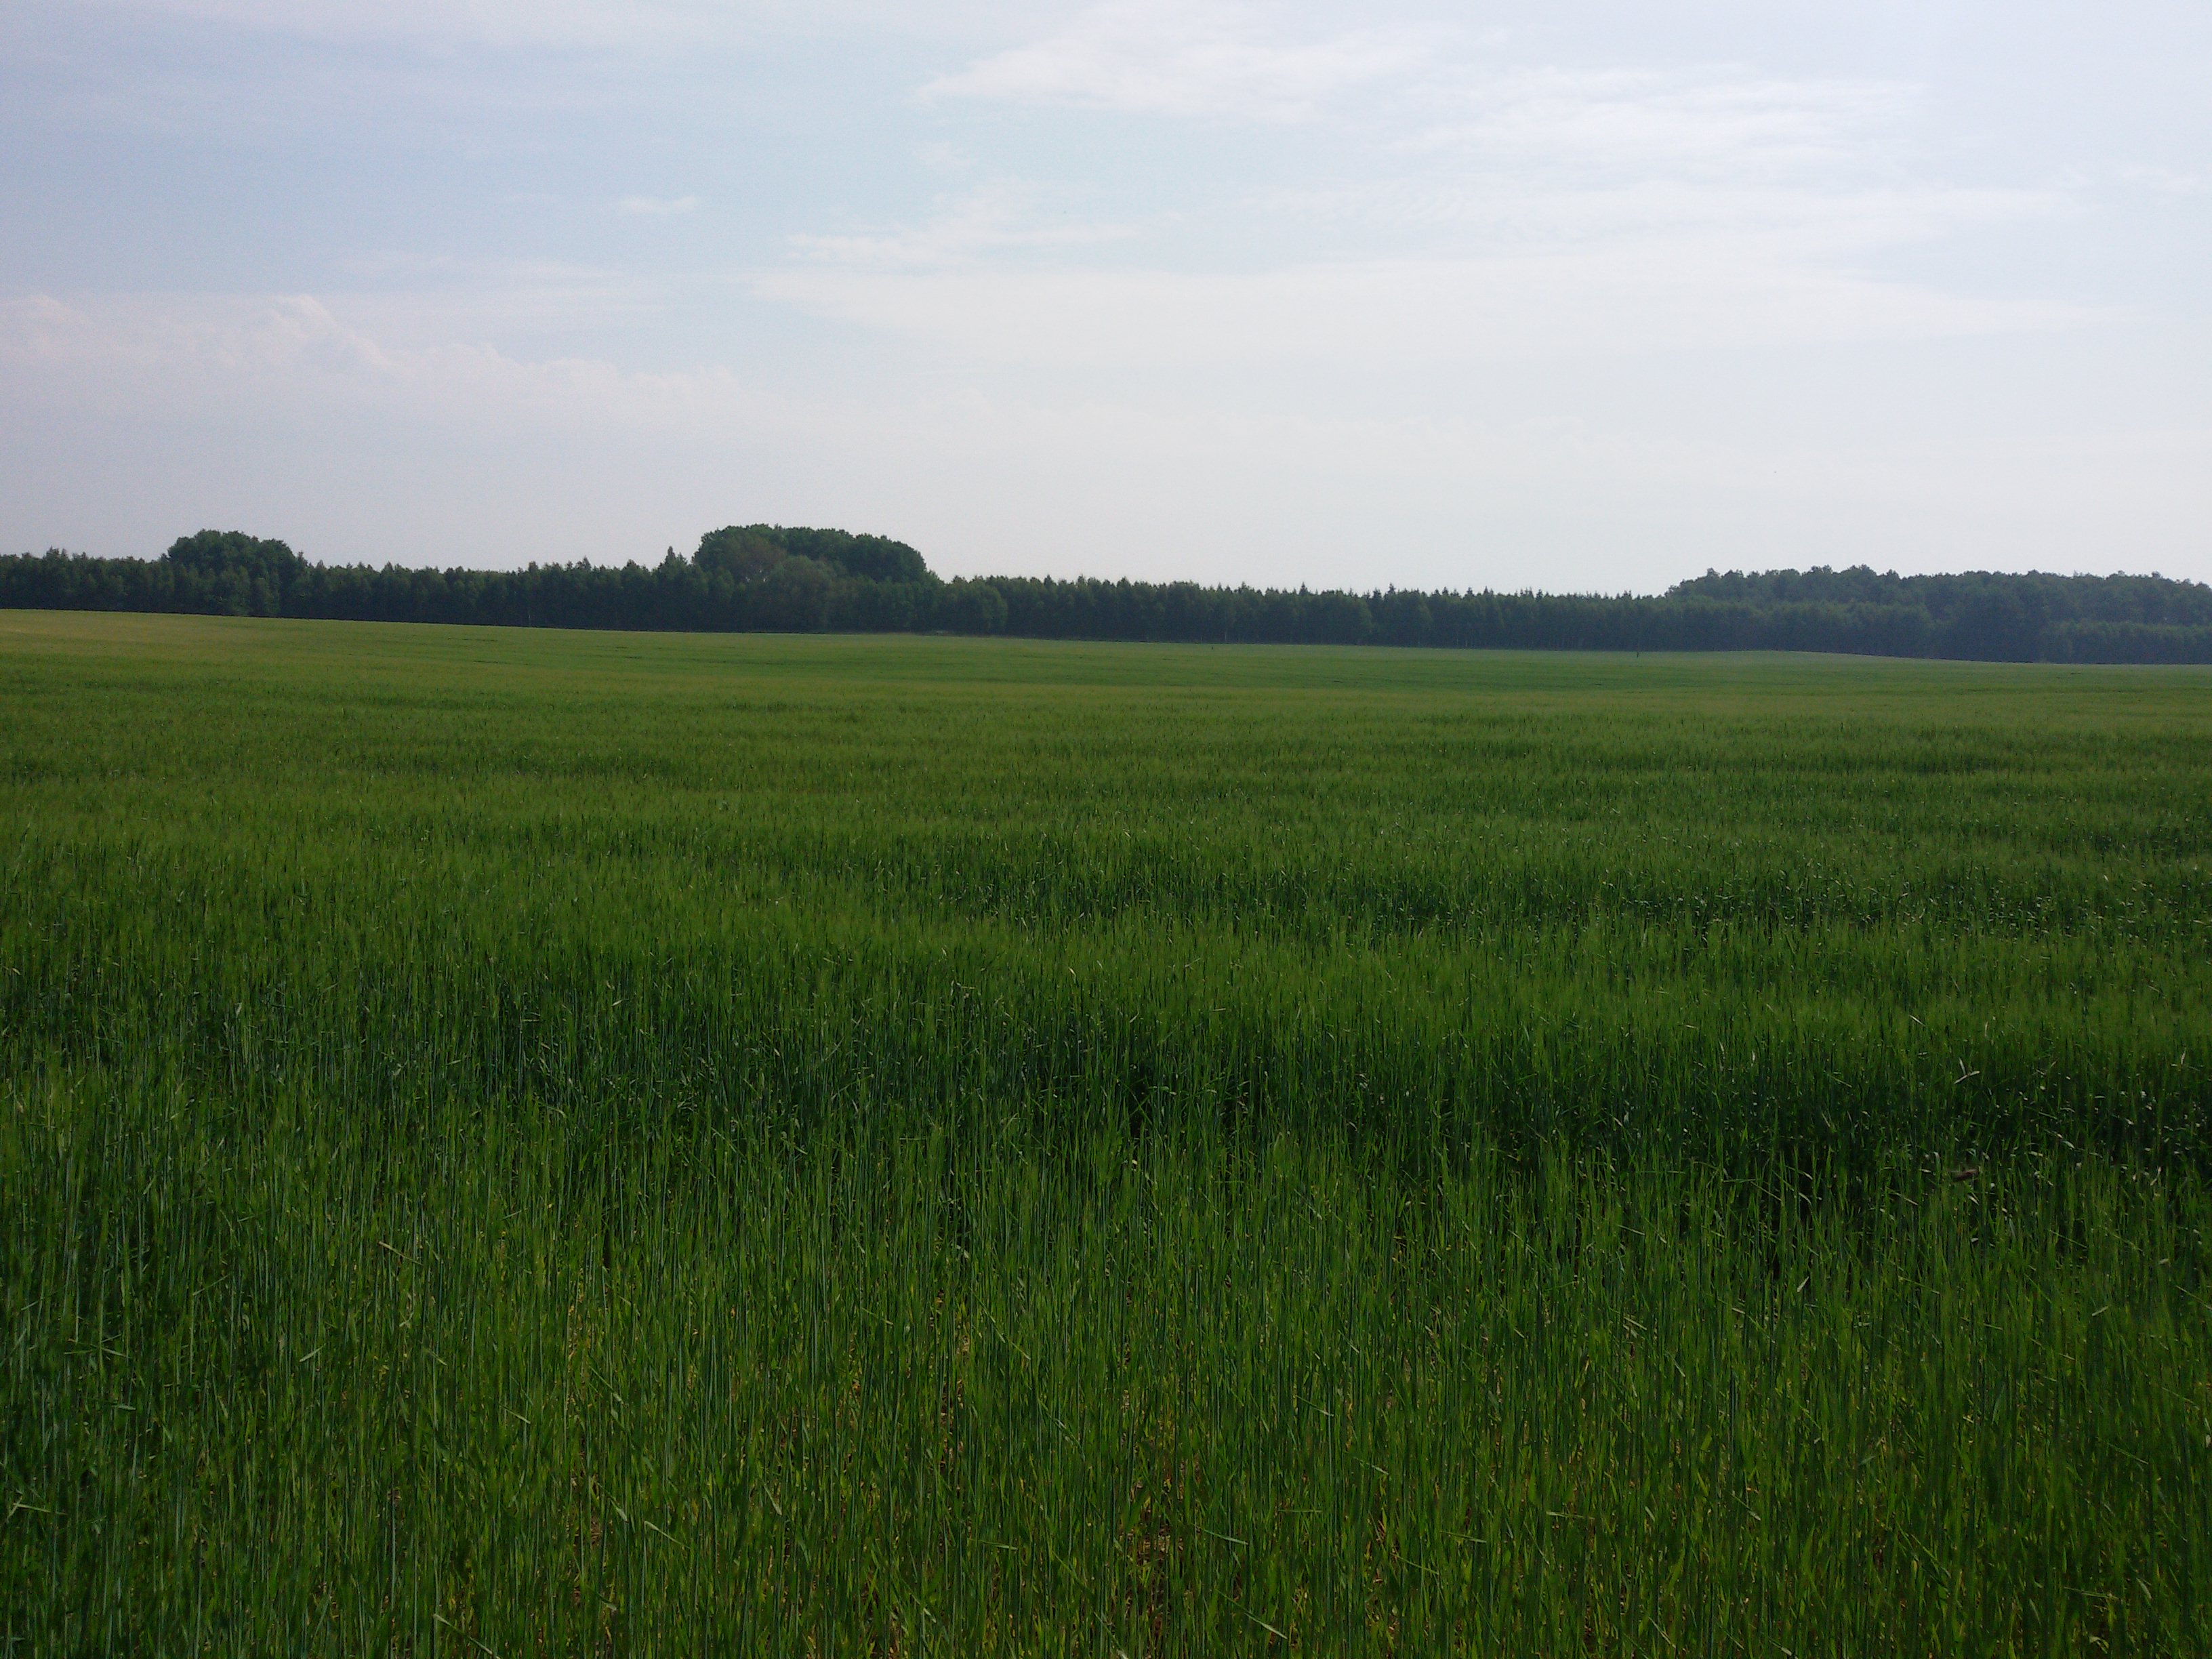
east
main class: Cropland
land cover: Barley
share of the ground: > 75 %
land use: Agriculture (excluding fallow land and kitchen gardens)
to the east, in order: Barley; Electric lines; Barley; Spruce dominated coniferous woodland
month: June
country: PL
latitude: 53.9081
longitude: 21.6664
